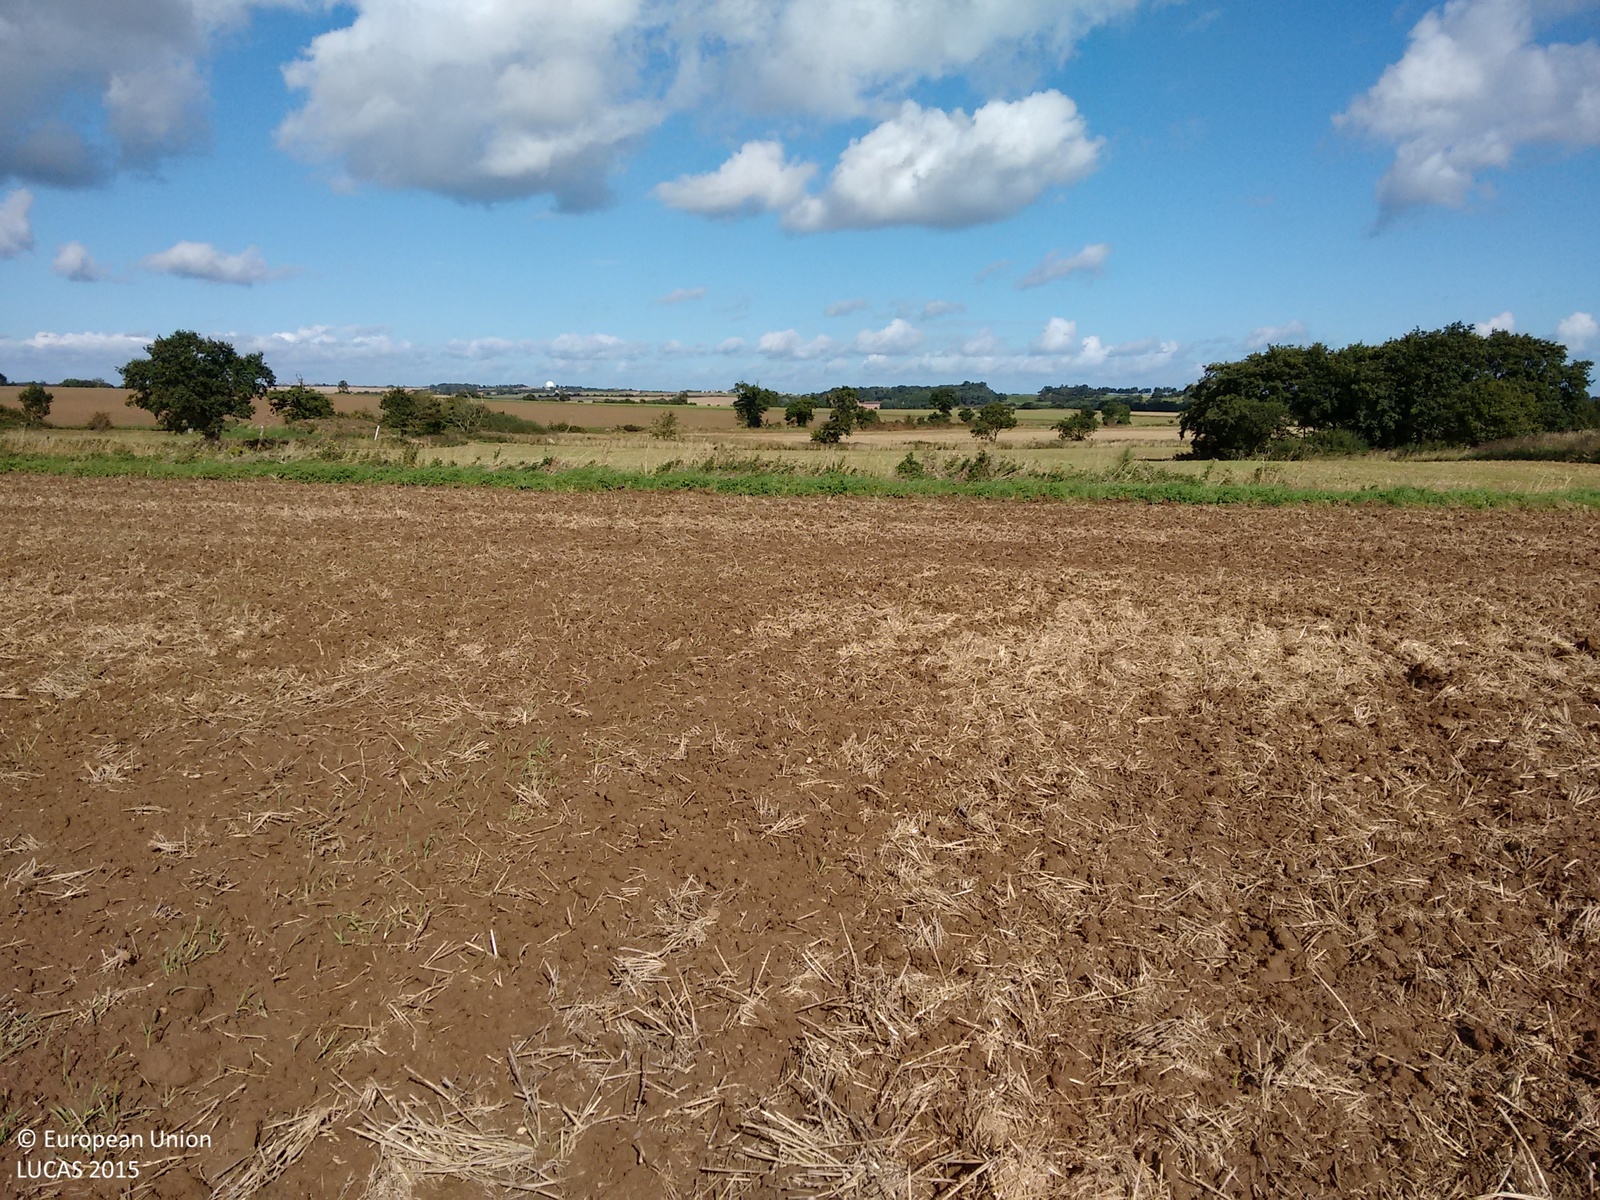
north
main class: Cropland
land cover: Common wheat
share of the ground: > 75 %
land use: Agriculture (excluding fallow land and kitchen gardens)
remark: Harvested field
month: September
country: GB
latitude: 52.8613
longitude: 1.4103
